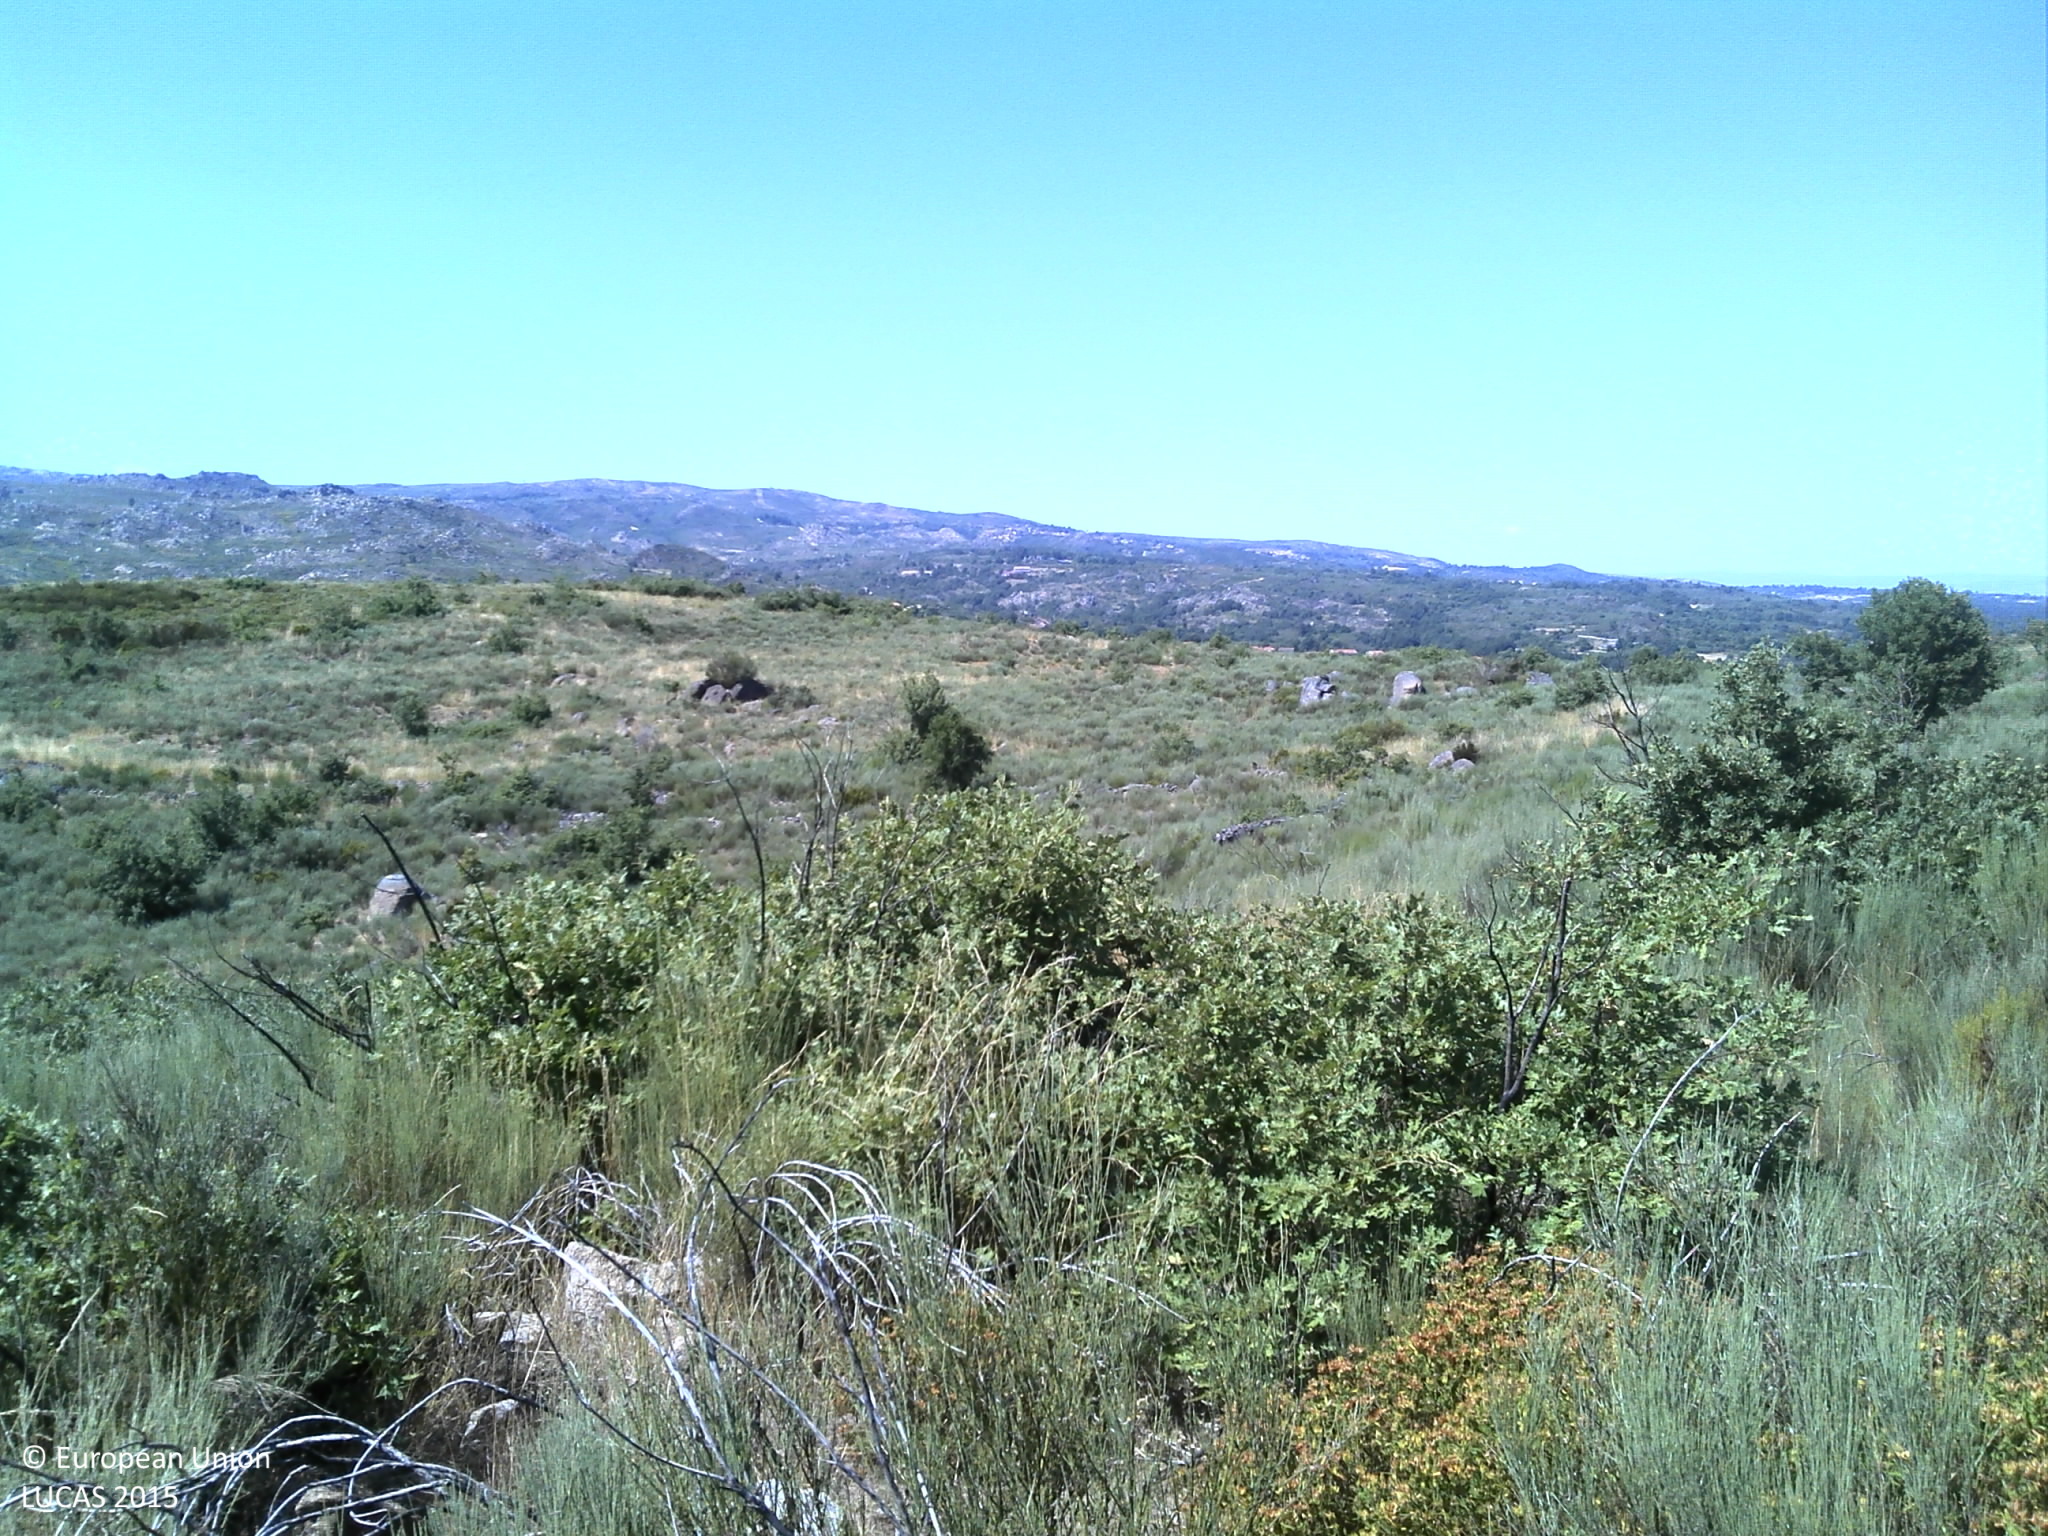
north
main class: Shrubland
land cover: Shrubland with sparse tree cover
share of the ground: > 75 %
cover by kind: shrubs 75 %, herbaceous plants 15 %, broadleaved forest trees 5 %, consolidated bare surface 5 %
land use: Agriculture (excluding fallow land and kitchen gardens)
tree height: < 5 m
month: July
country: PT
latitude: 41.7514
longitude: -7.5585
